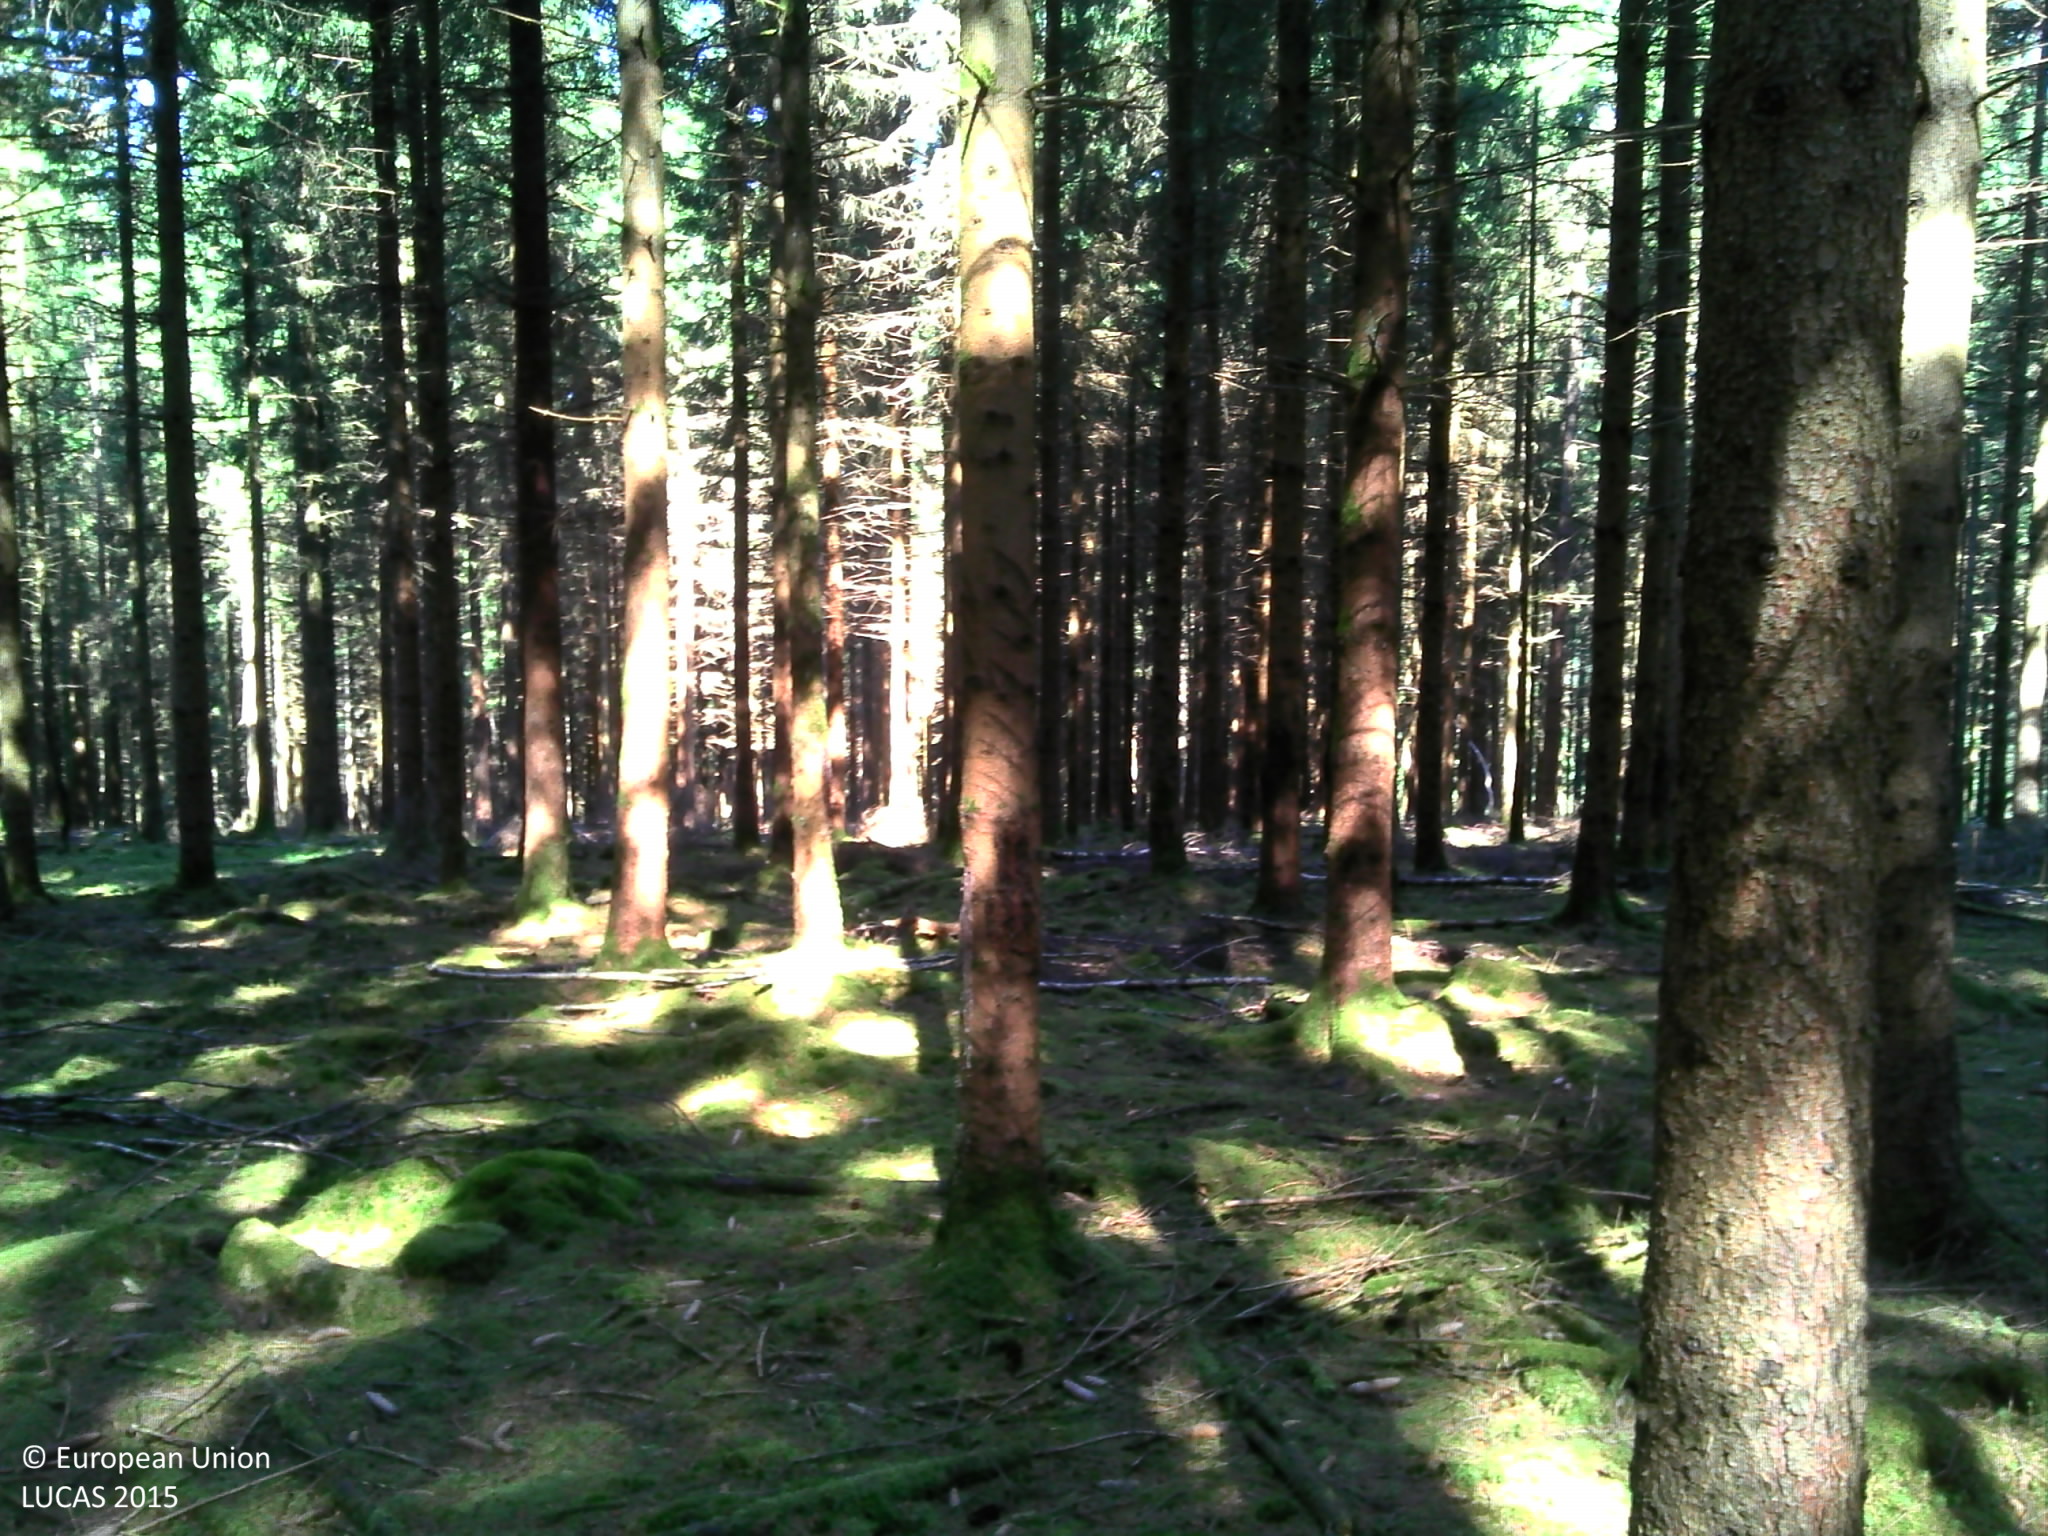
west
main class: Woodland
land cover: Spruce dominated coniferous woodland
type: alpine coniferous forest
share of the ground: > 75 %
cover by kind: coniferous forest trees 95 %, lichens and mosses 5 %
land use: Forestry
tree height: > 5 m
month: July
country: BE
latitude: 50.1773
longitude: 5.7558
